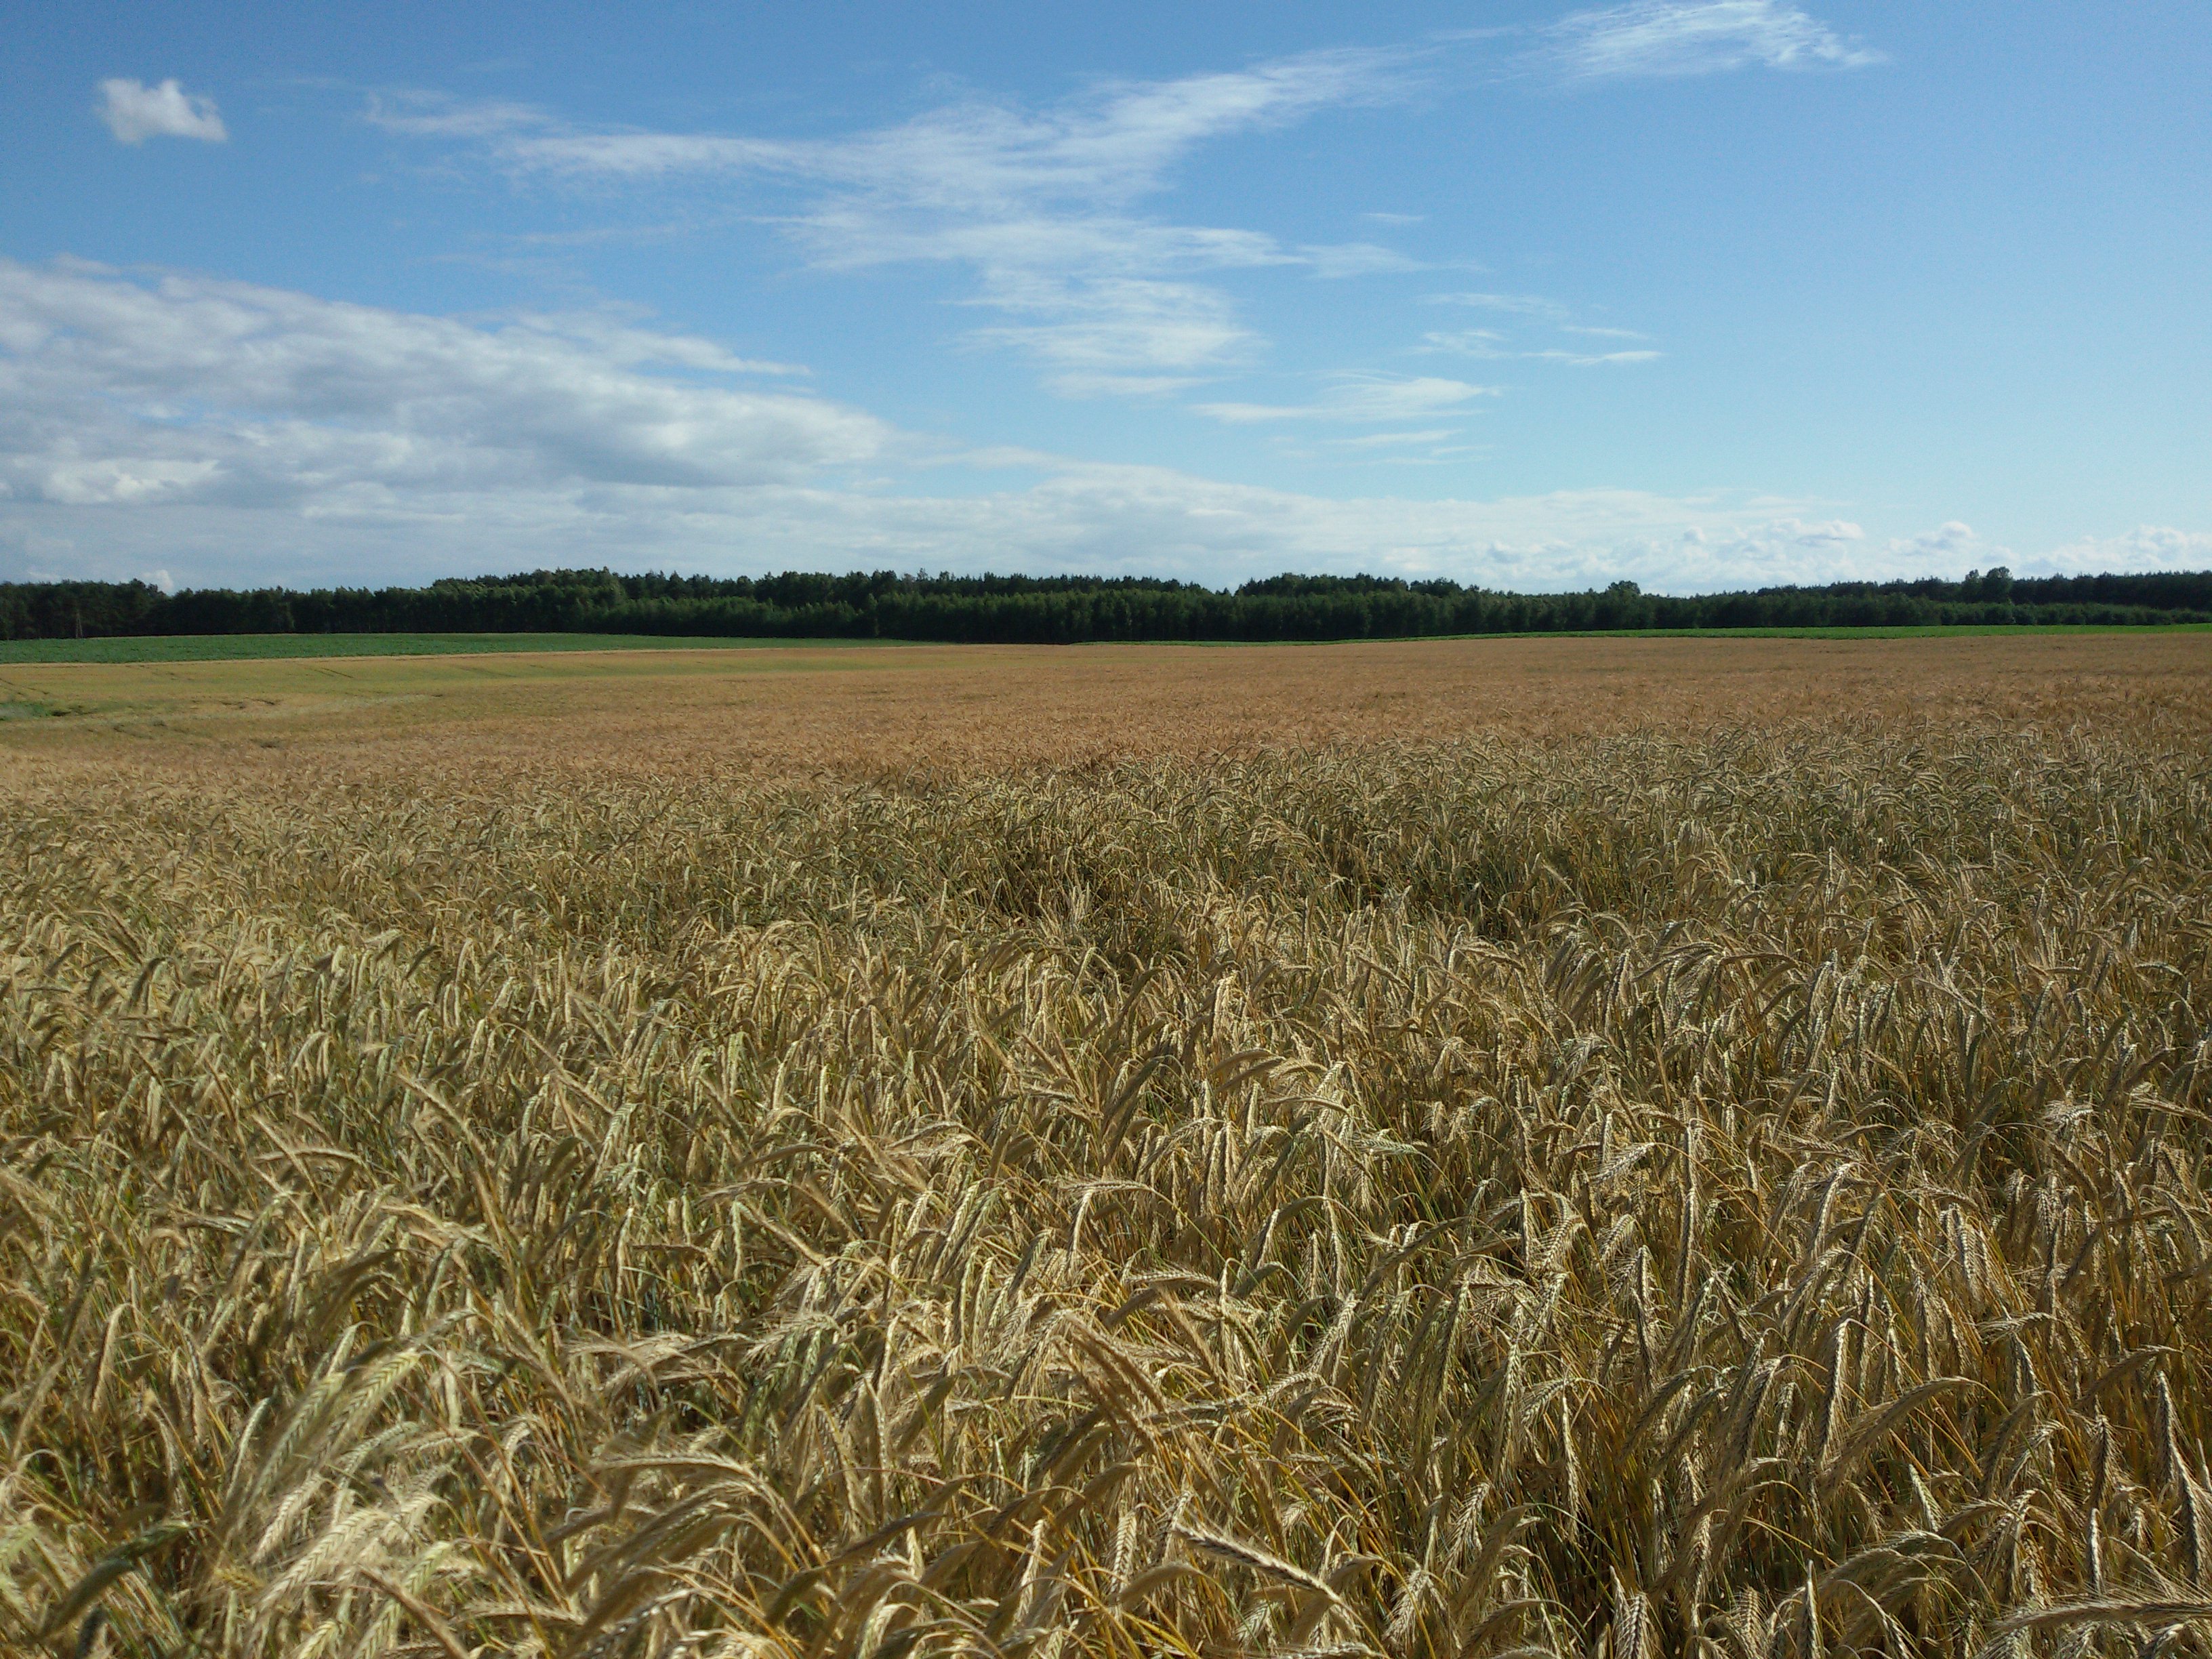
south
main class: Cropland
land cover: Triticale
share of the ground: > 75 %
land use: Agriculture (excluding fallow land and kitchen gardens)
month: July
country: PL
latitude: 52.7290
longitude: 17.6094
